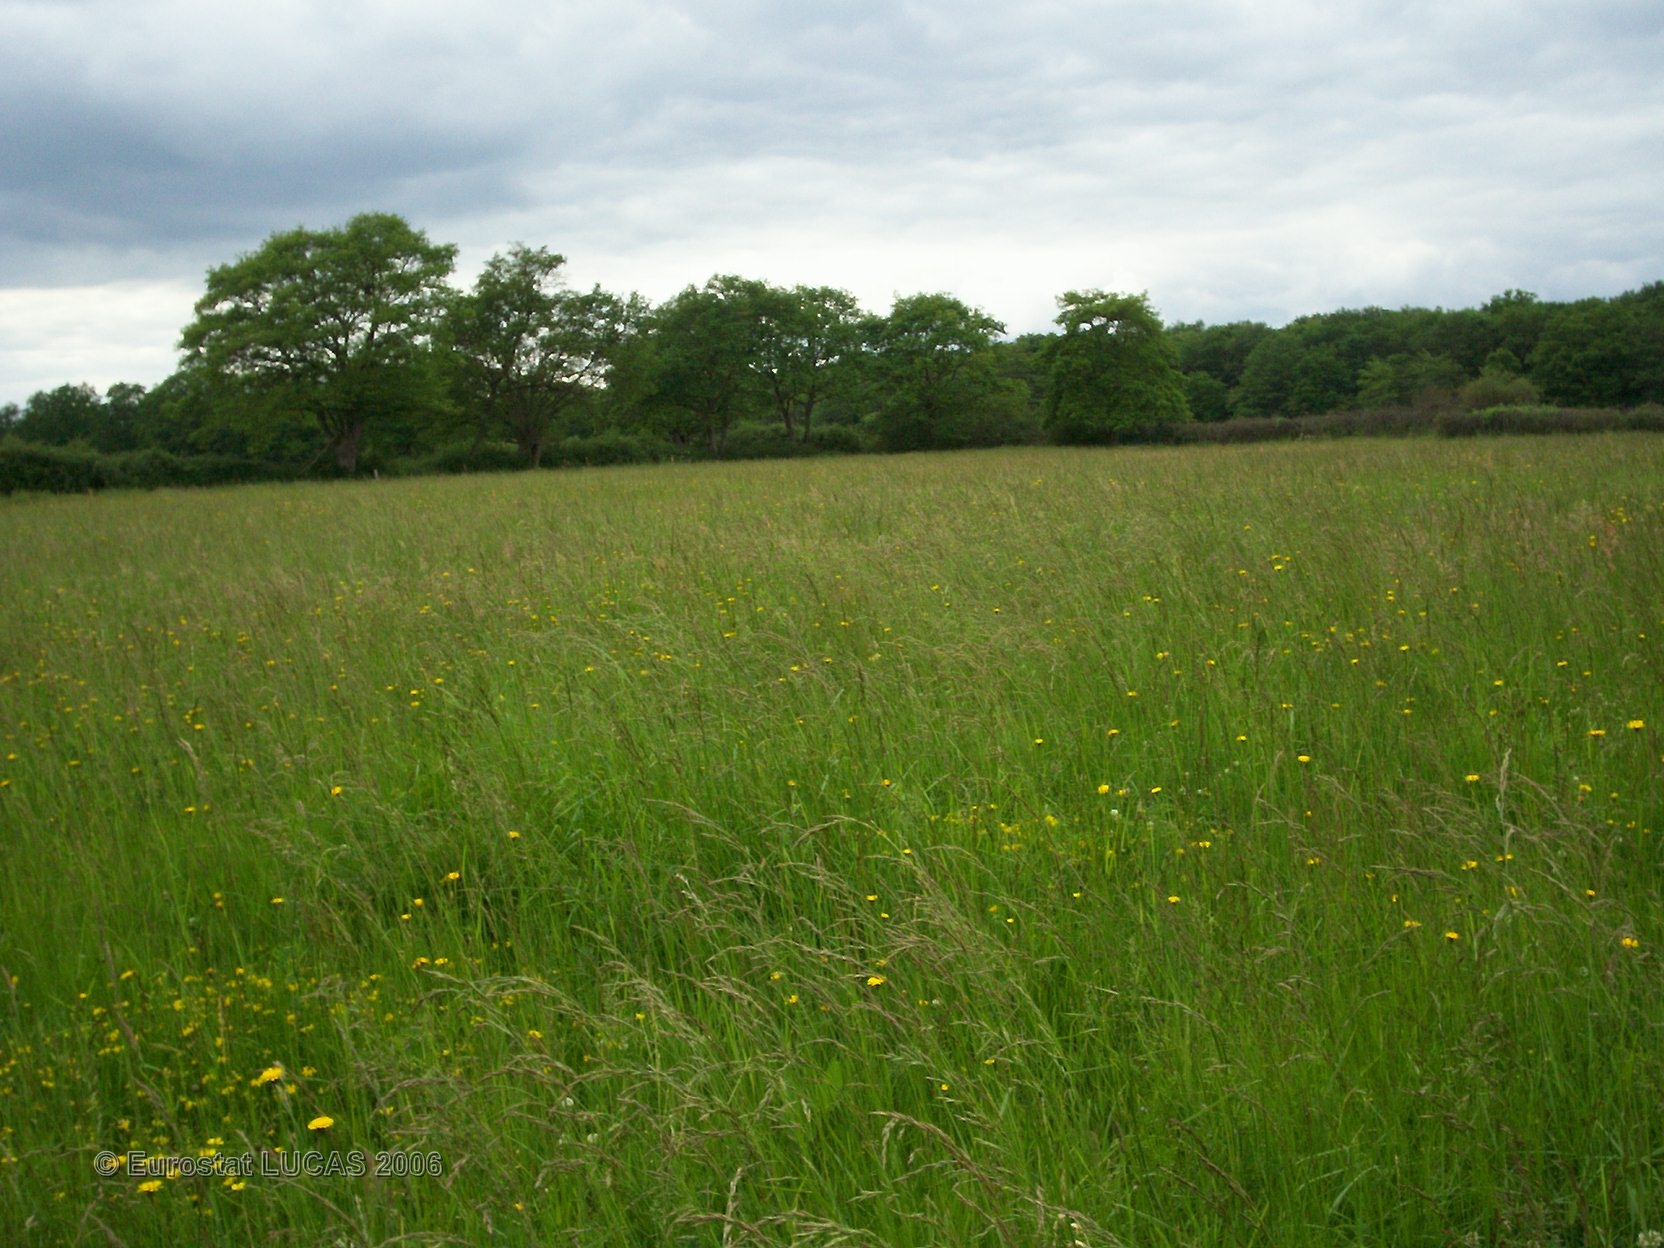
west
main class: Grassland
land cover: Grassland without tree/shrub cover
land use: Agriculture (excluding fallow land and kitchen gardens)
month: May
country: FR
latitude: 46.8648
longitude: 3.0304
